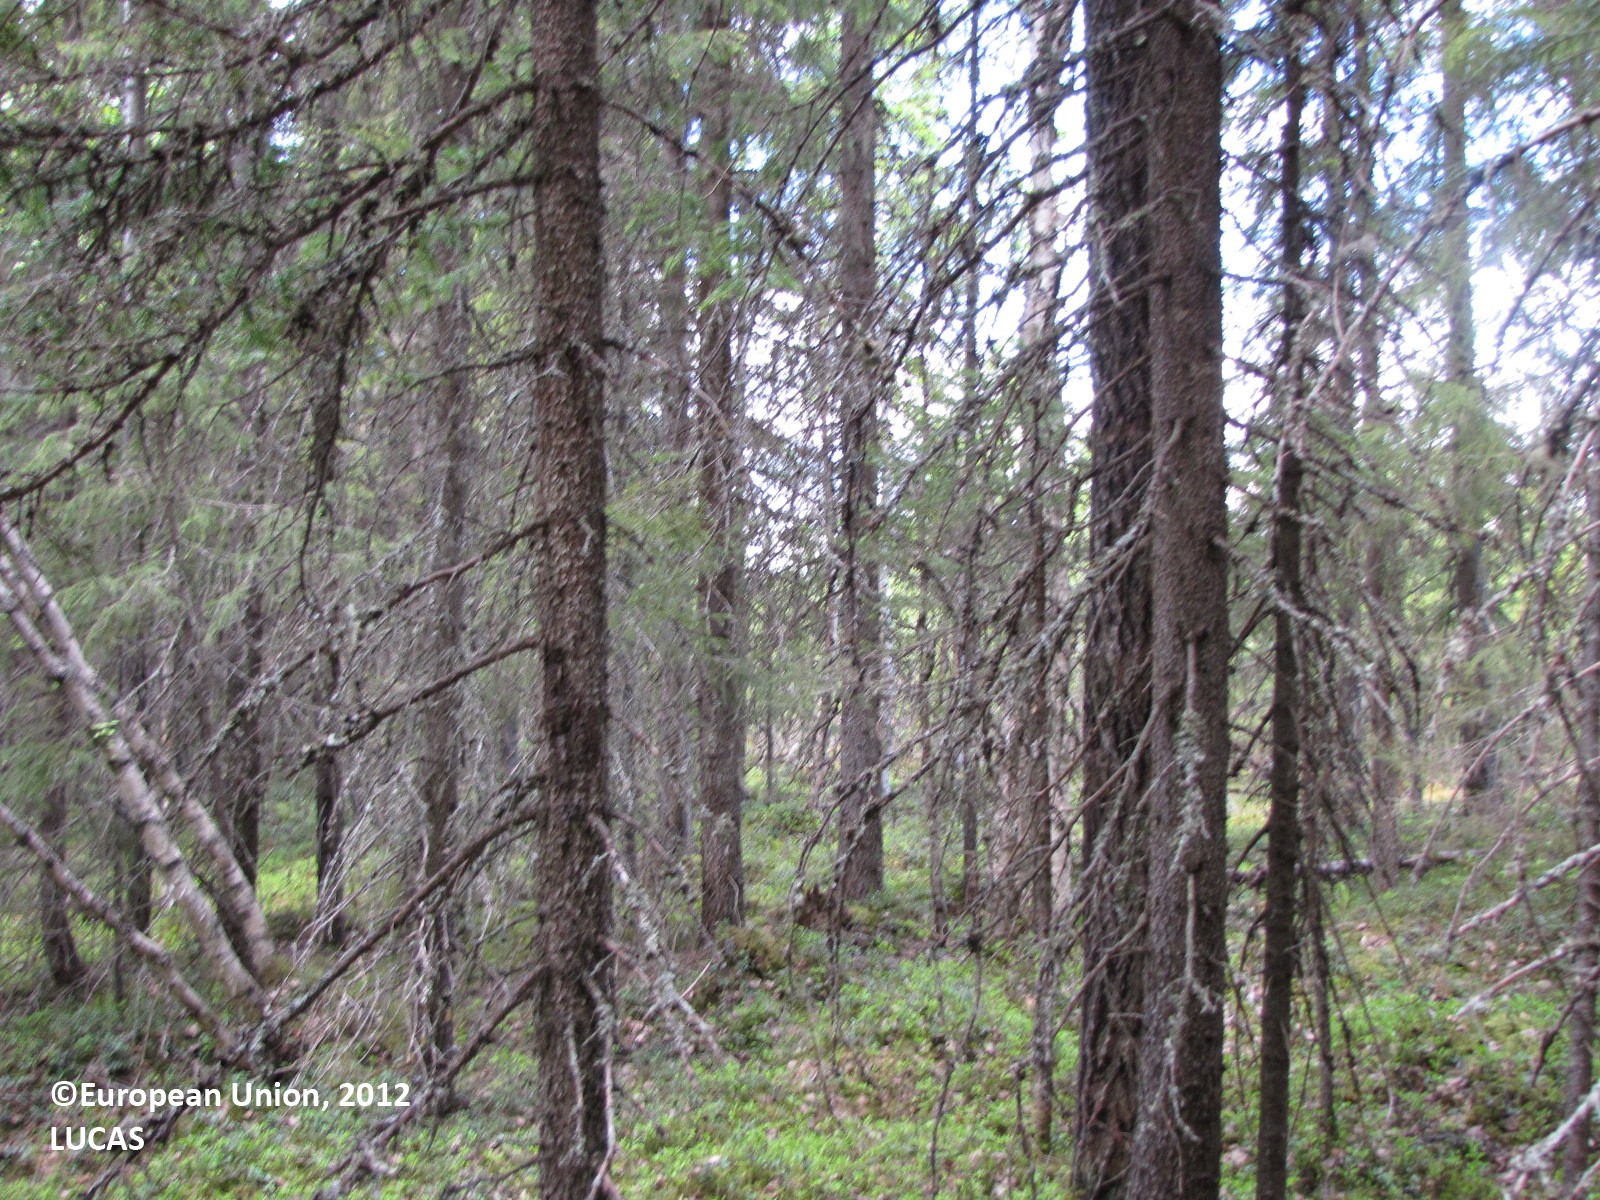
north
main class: Woodland
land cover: Spruce dominated coniferous woodland
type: boreal forest
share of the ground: 50 - 75 %
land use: Forestry
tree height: > 5 m
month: June
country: FI
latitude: 65.9908
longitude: 24.5672
